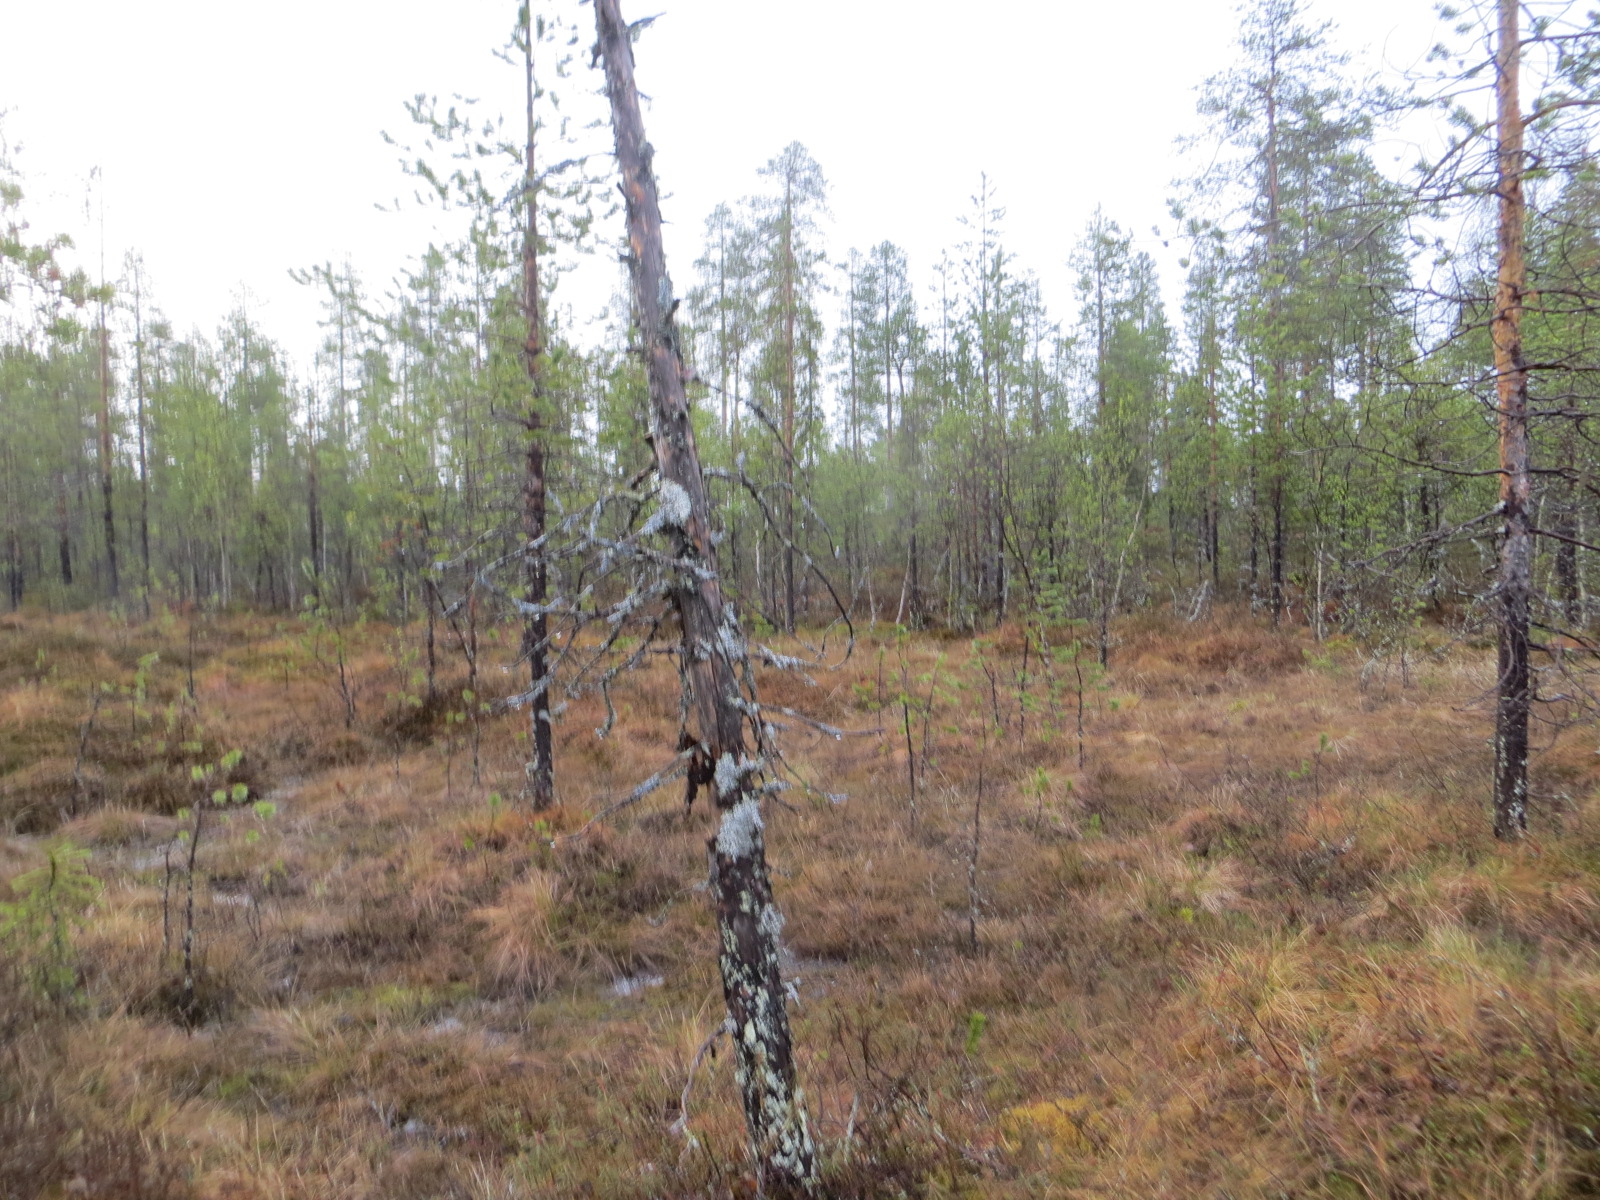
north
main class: Woodland
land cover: Pine dominated coniferous woodland
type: mire and swamp forests
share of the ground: 25 - 50 %
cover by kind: coniferous forest trees 40 %, shrubs 40 %, herbaceous plants 15 %, lichens and mosses 5 %
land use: Forestry
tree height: > 5 m
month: June
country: FI
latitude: 66.9035
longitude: 25.3374
